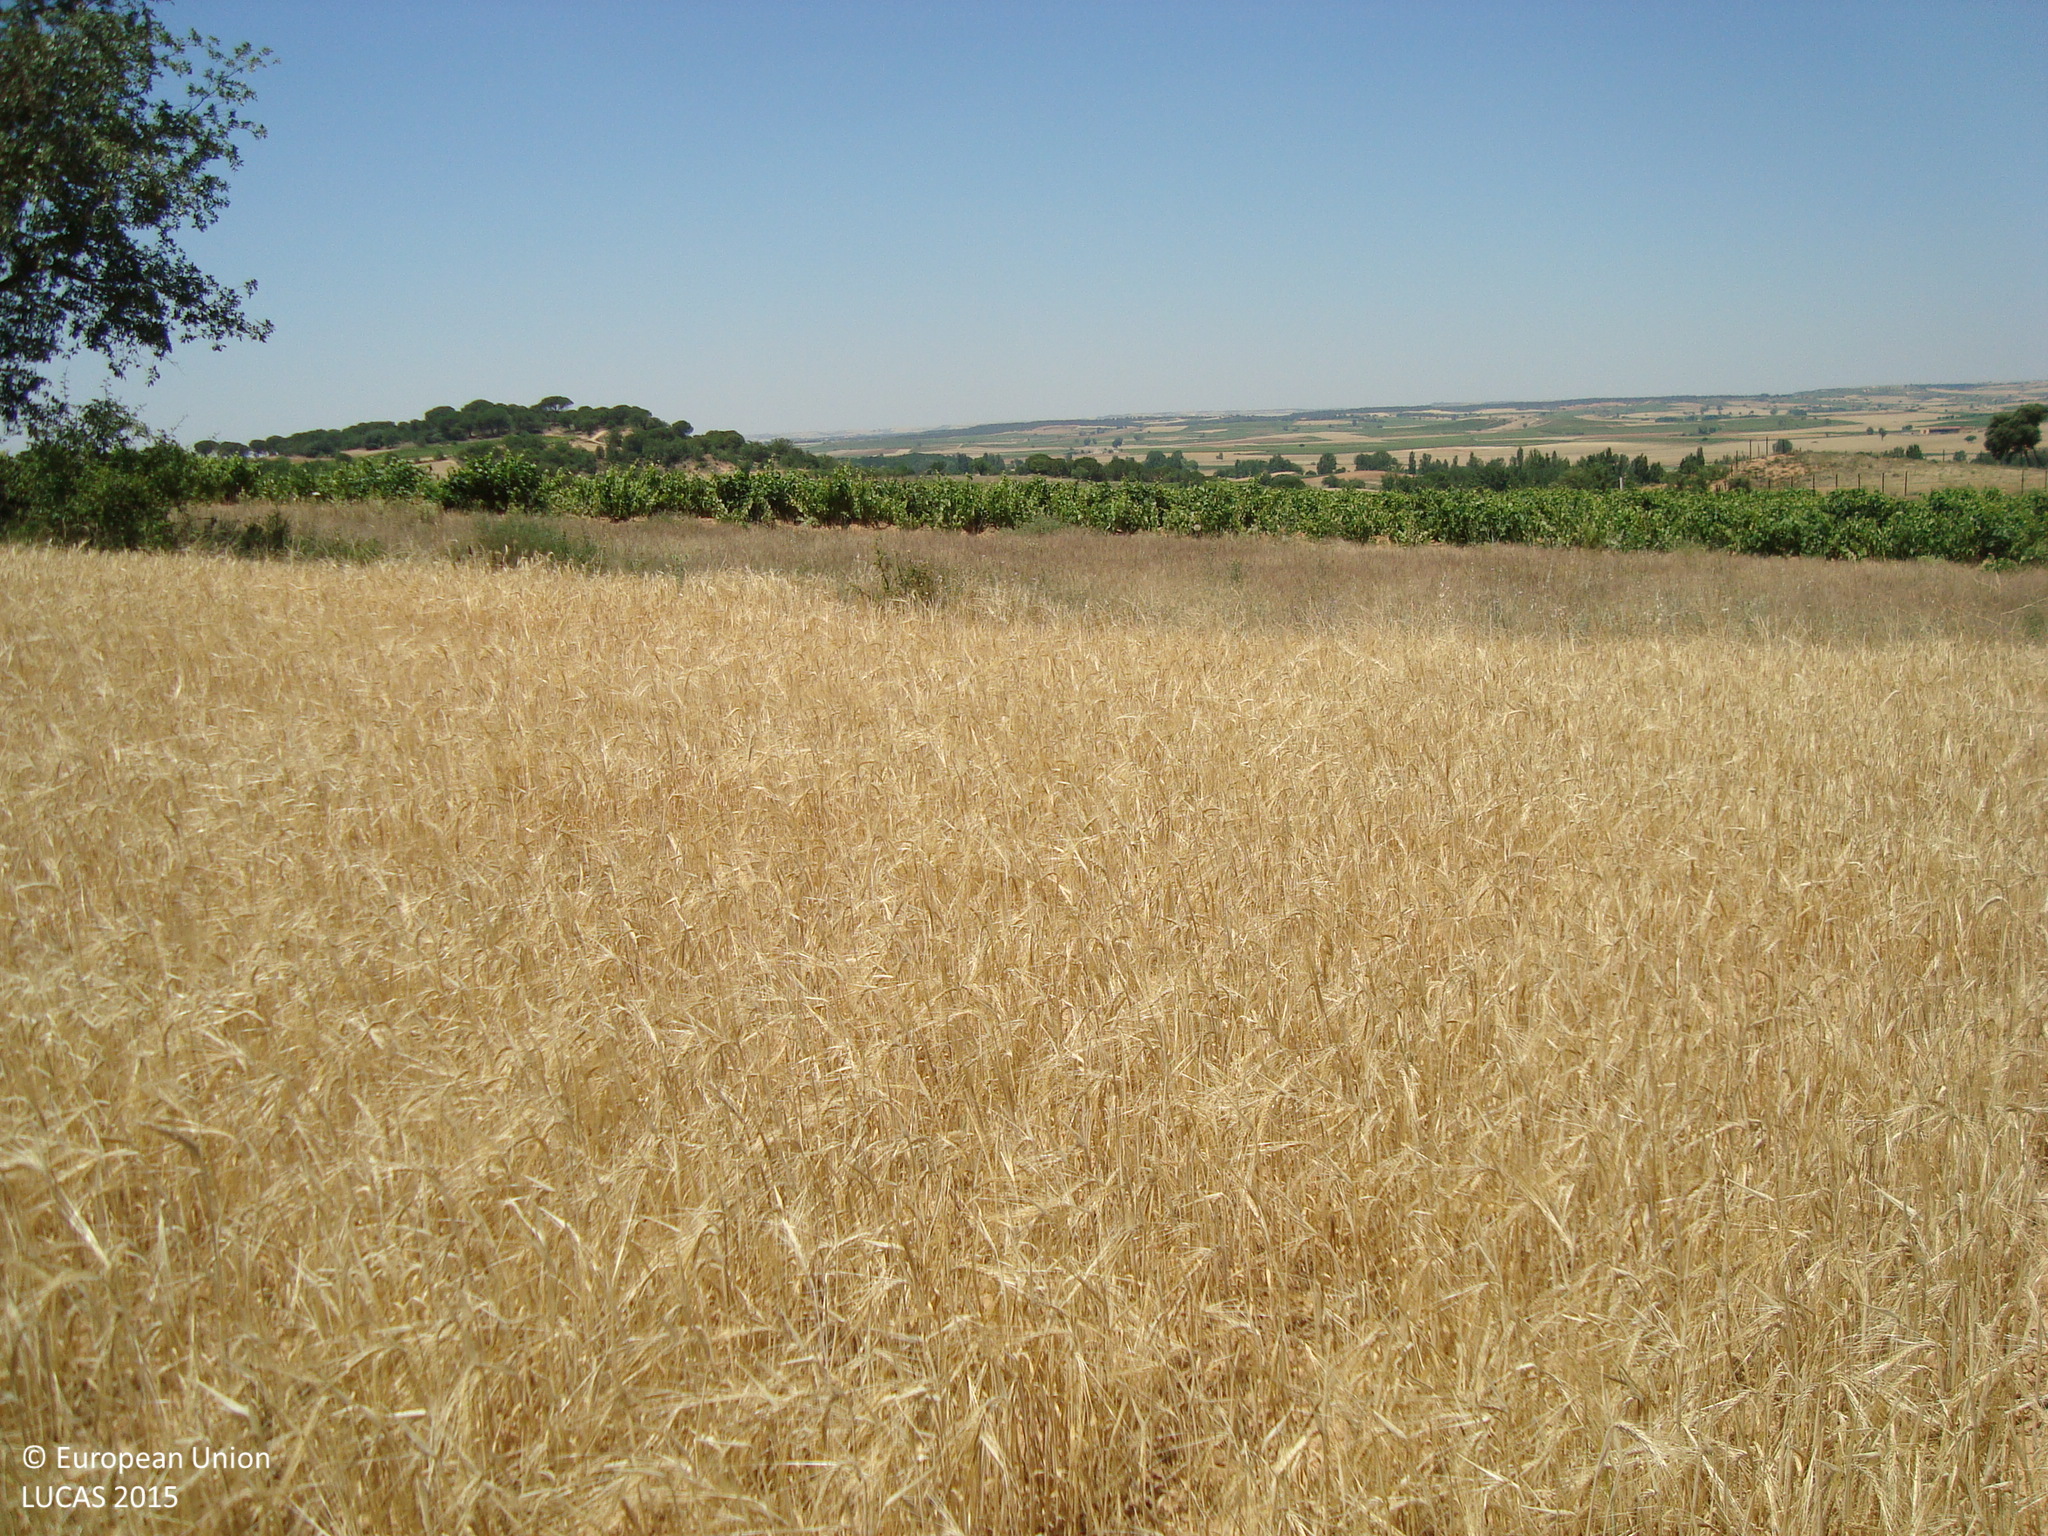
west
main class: Cropland
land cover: Barley
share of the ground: > 75 %
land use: Agriculture (excluding fallow land and kitchen gardens)
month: June
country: ES
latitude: 41.7266
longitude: -3.7711
